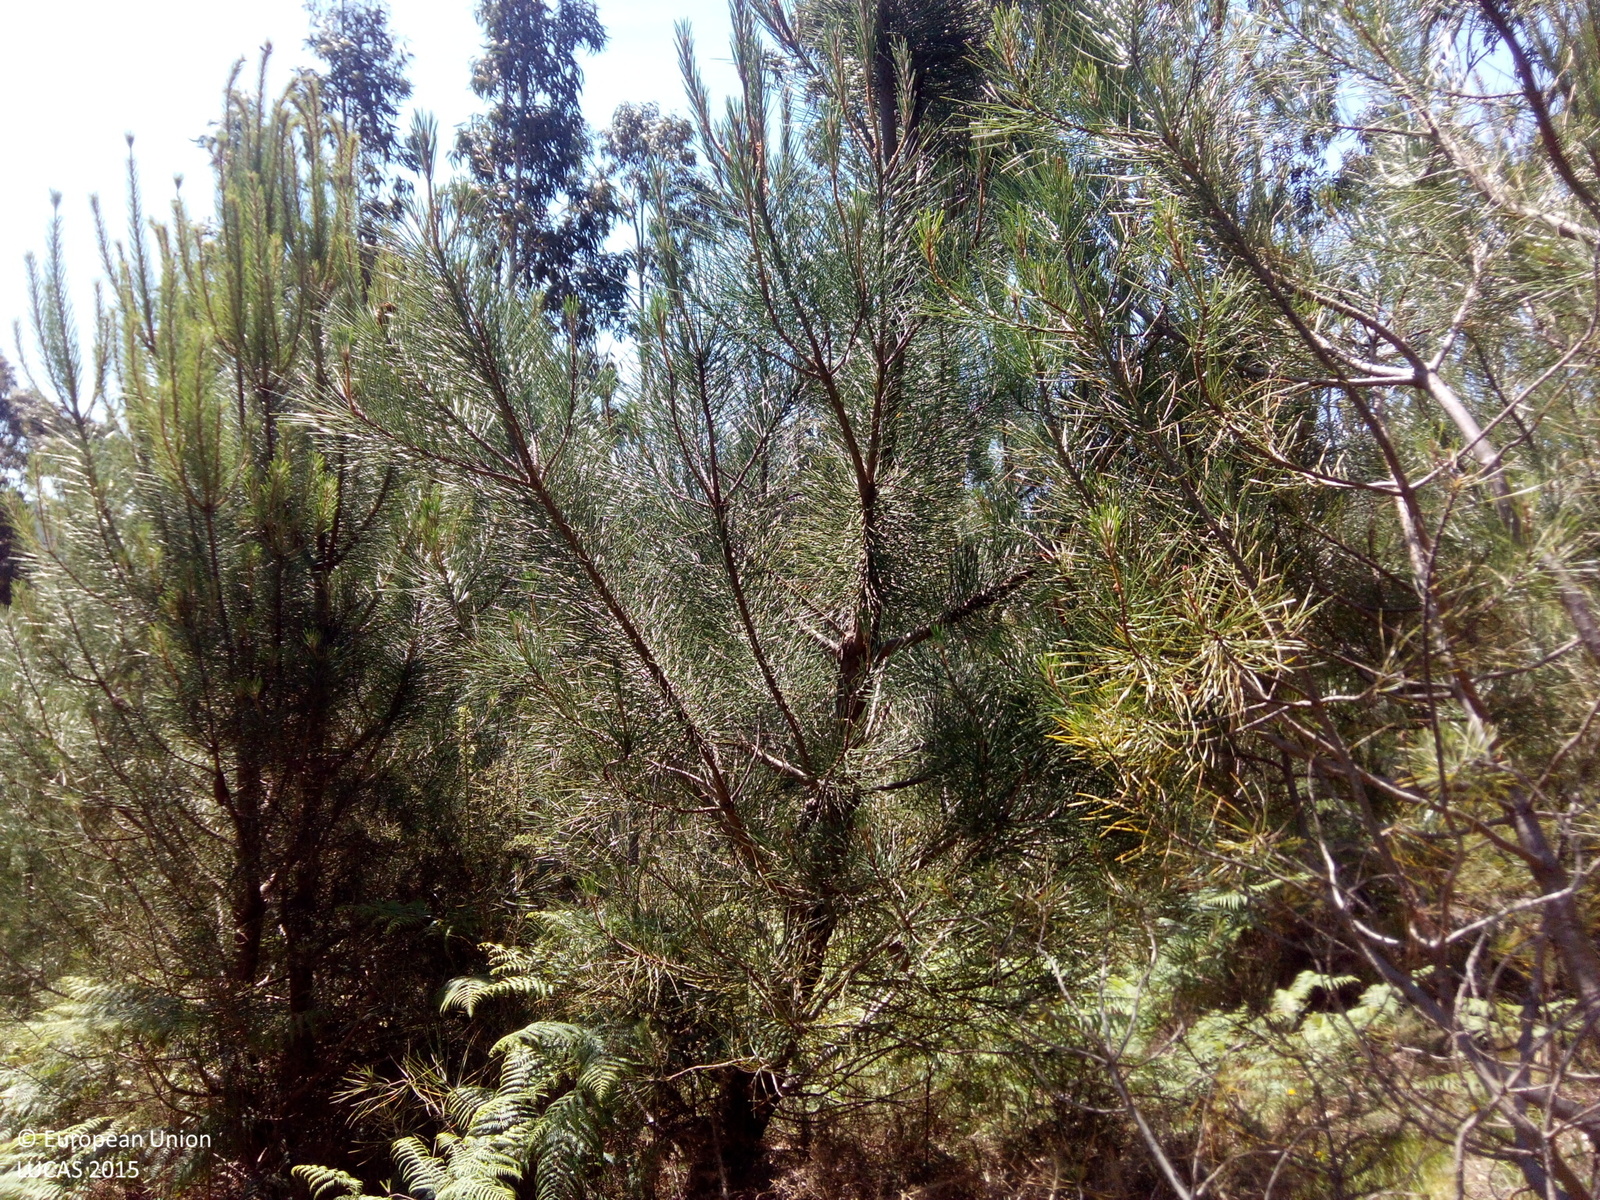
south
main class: Woodland
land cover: Pine dominated coniferous woodland
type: exotic forest
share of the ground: > 75 %
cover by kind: coniferous forest trees 70 %, shrubs 20 %, herbaceous plants 10 %
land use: Forestry
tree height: > 5 m
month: May
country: ES
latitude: 42.6470
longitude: -9.0099
